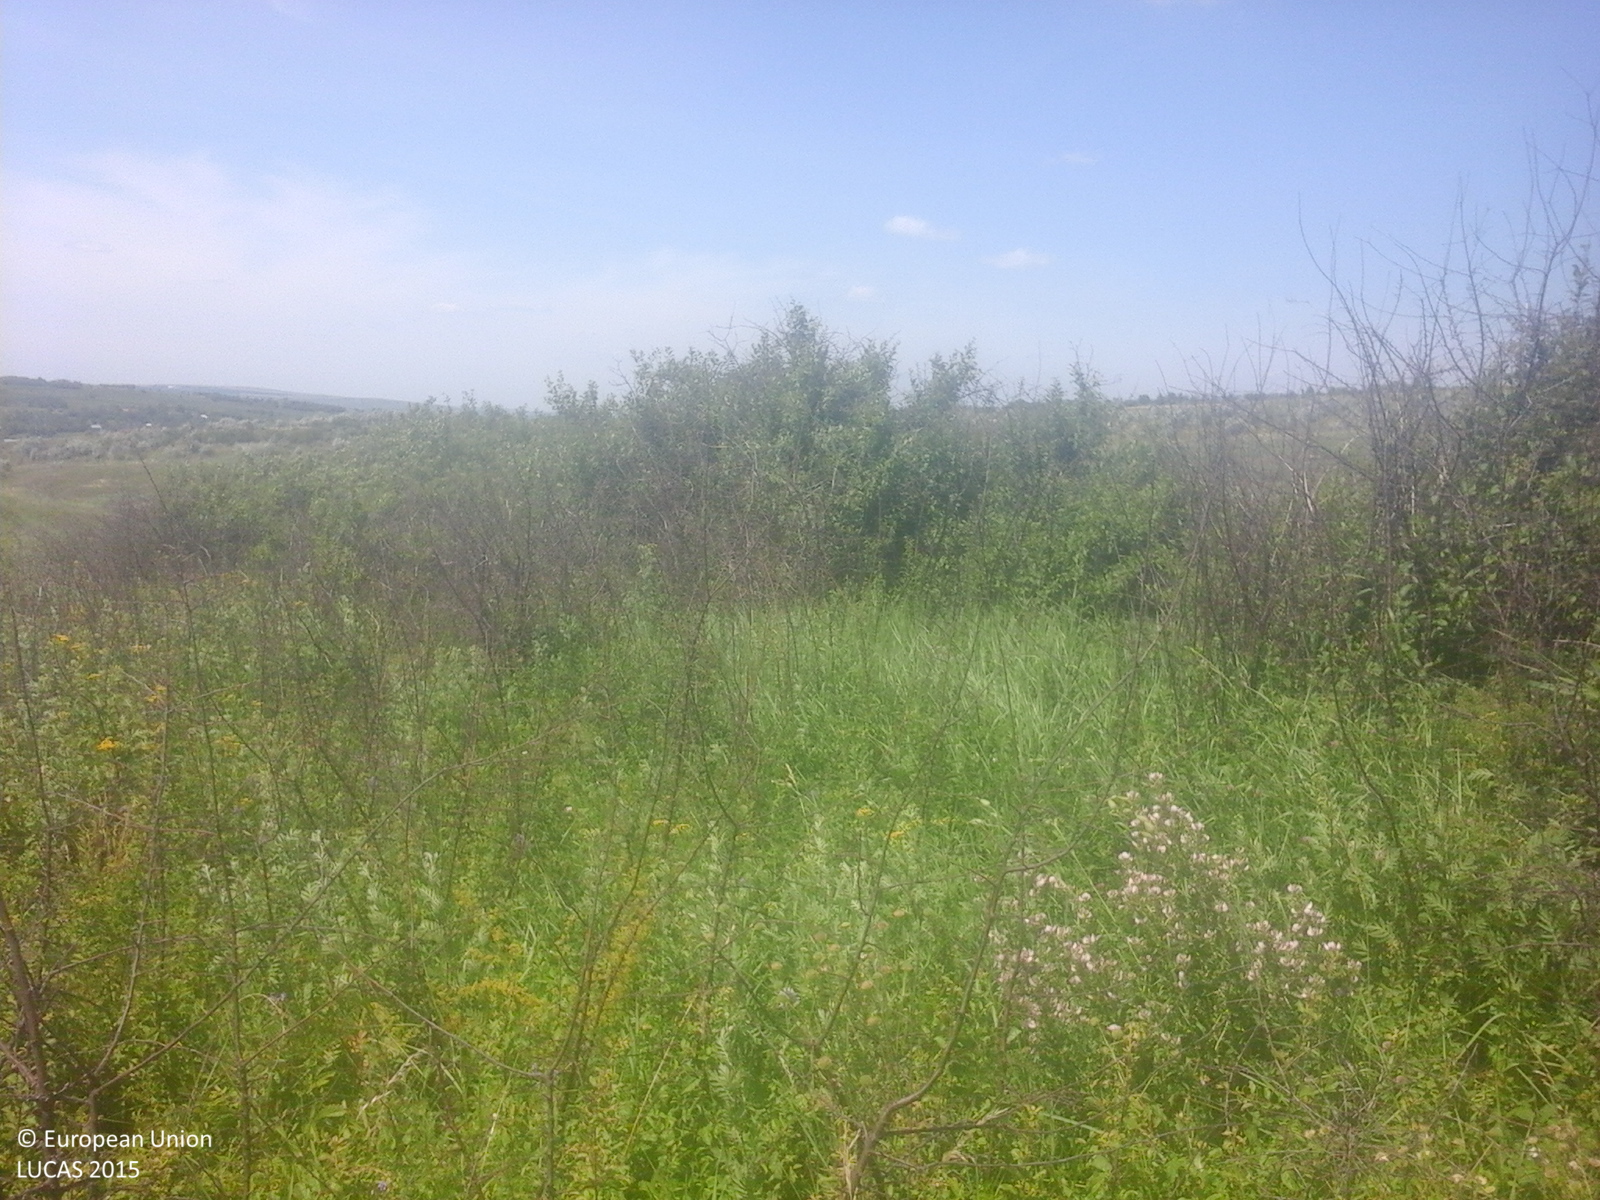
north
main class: Shrubland
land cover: Shrubland without tree cover
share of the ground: > 75 %
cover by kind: shrubs 80 %, herbaceous plants 20 %
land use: Semi-natural and natural areas not in use
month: June
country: RO
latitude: 47.9176
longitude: 26.8965
